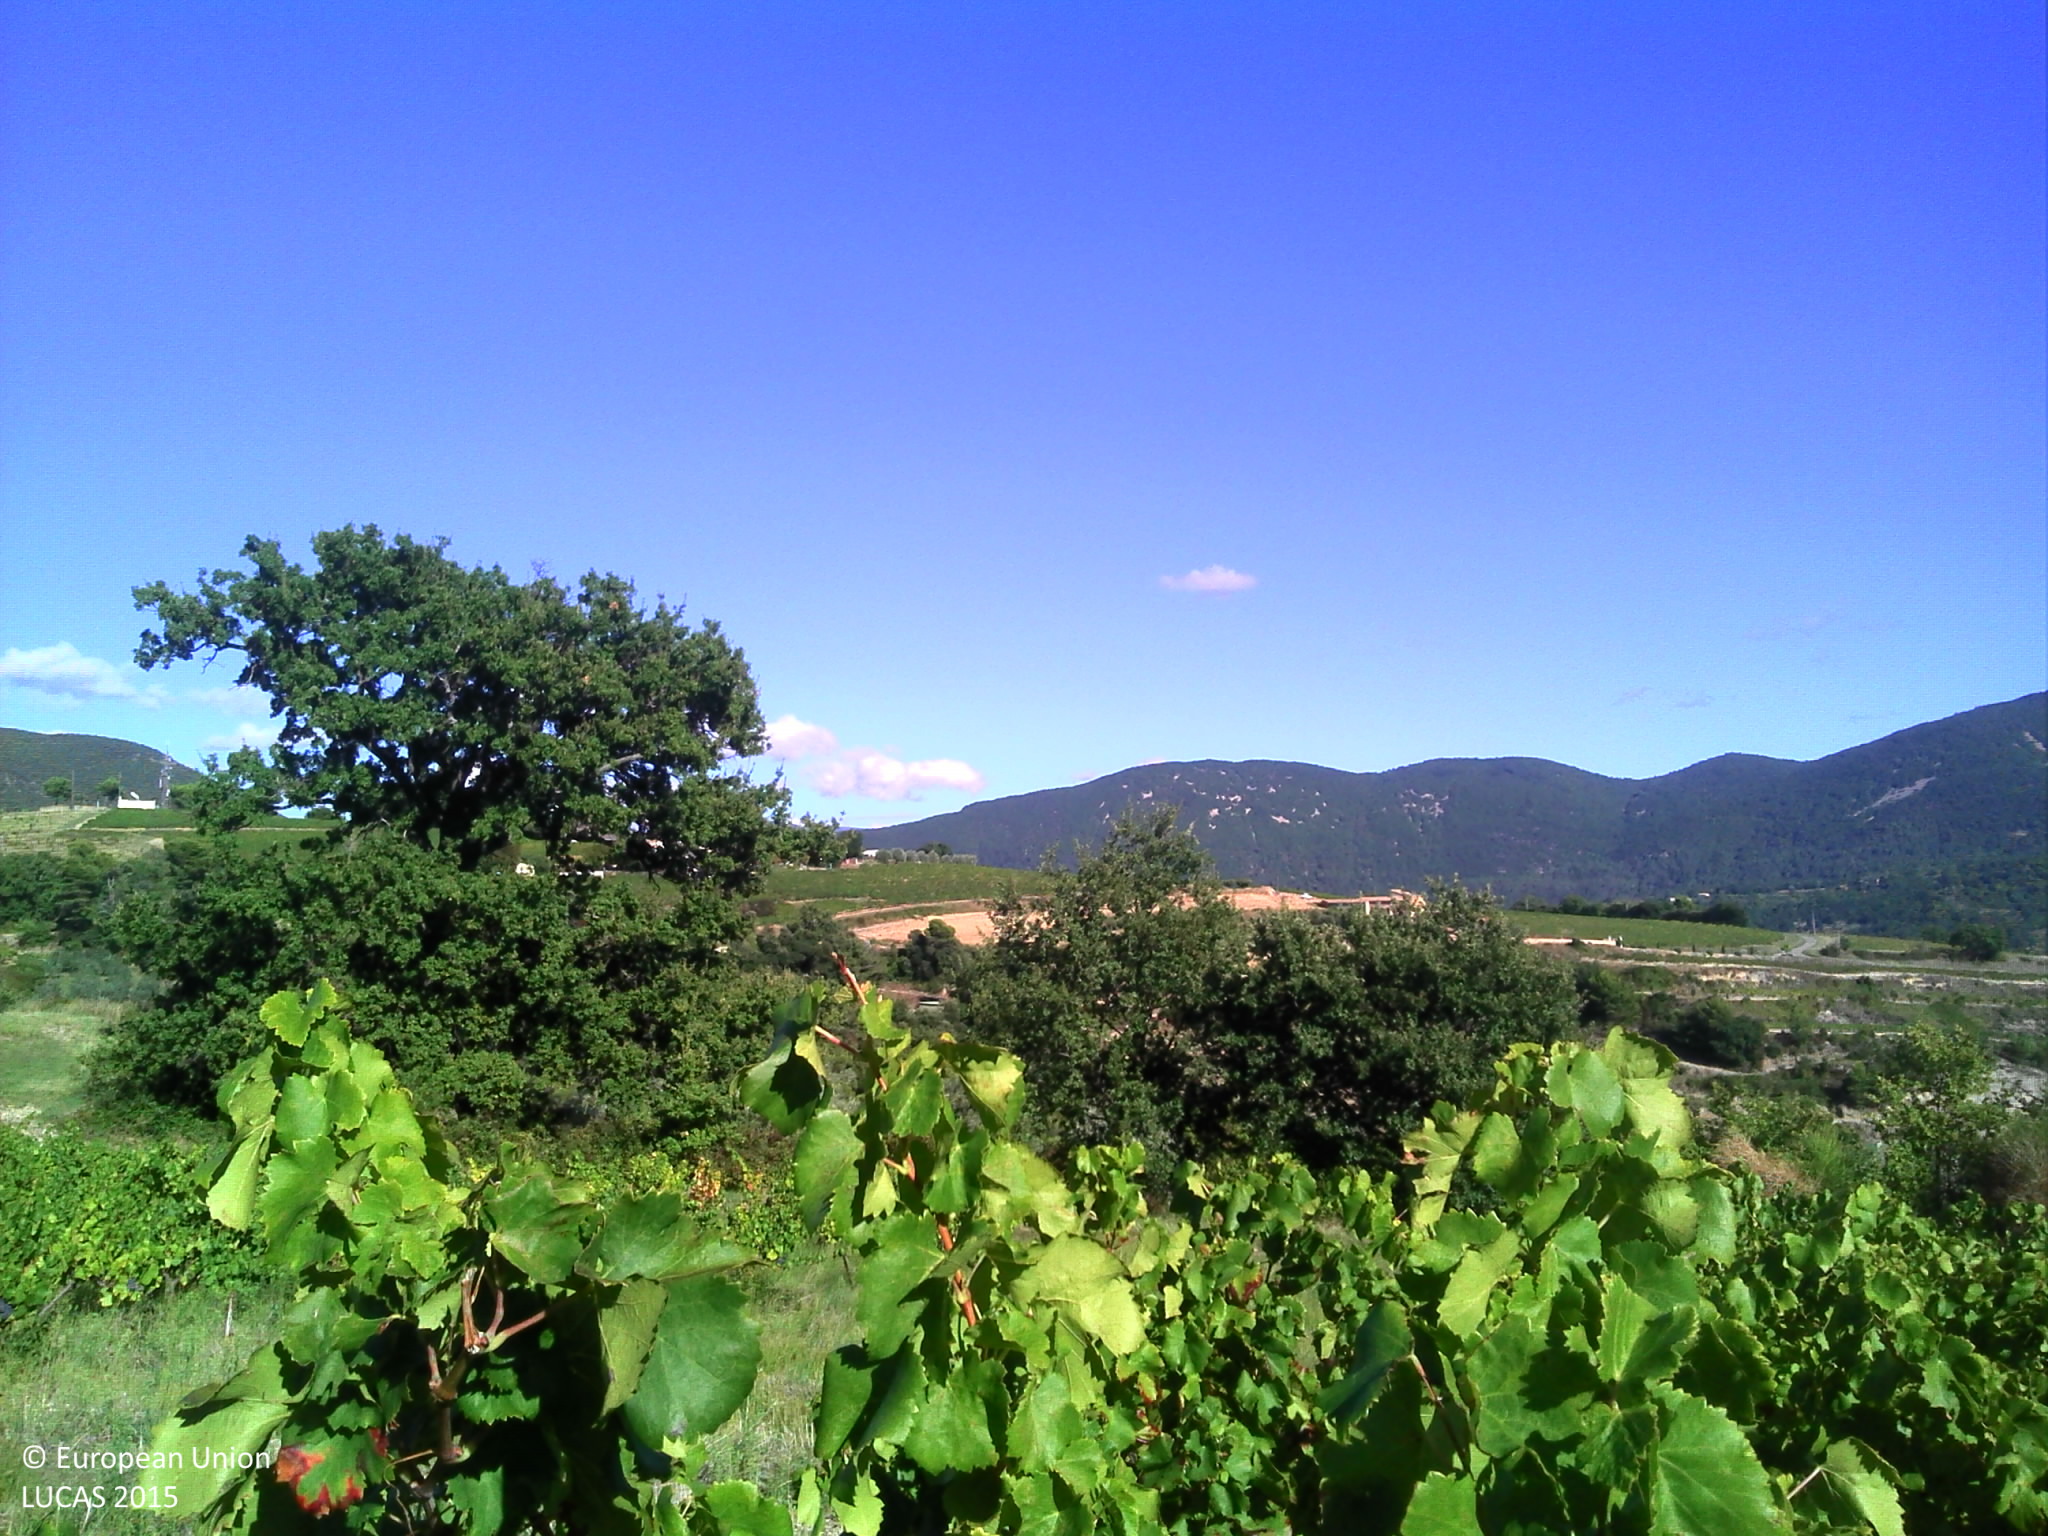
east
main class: Cropland
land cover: Vineyards
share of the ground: 10 - 25 %
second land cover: Spontaneously vegetated surfaces
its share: > 75 %
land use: Agriculture (excluding fallow land and kitchen gardens)
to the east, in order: Vineyards; Spontaneously vegetated surfaces; Abandoned hedges; Tracks; Olive groves; Grass margins; Vineyards; Abandoned hedges; Tracks; Vineyards; Abandoned hedges; Vineyards; Abandoned hedges; Olive groves; Abandoned hedges; Vineyards; Broadleaved woodland
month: September
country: FR
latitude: 44.3614
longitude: 5.1014
